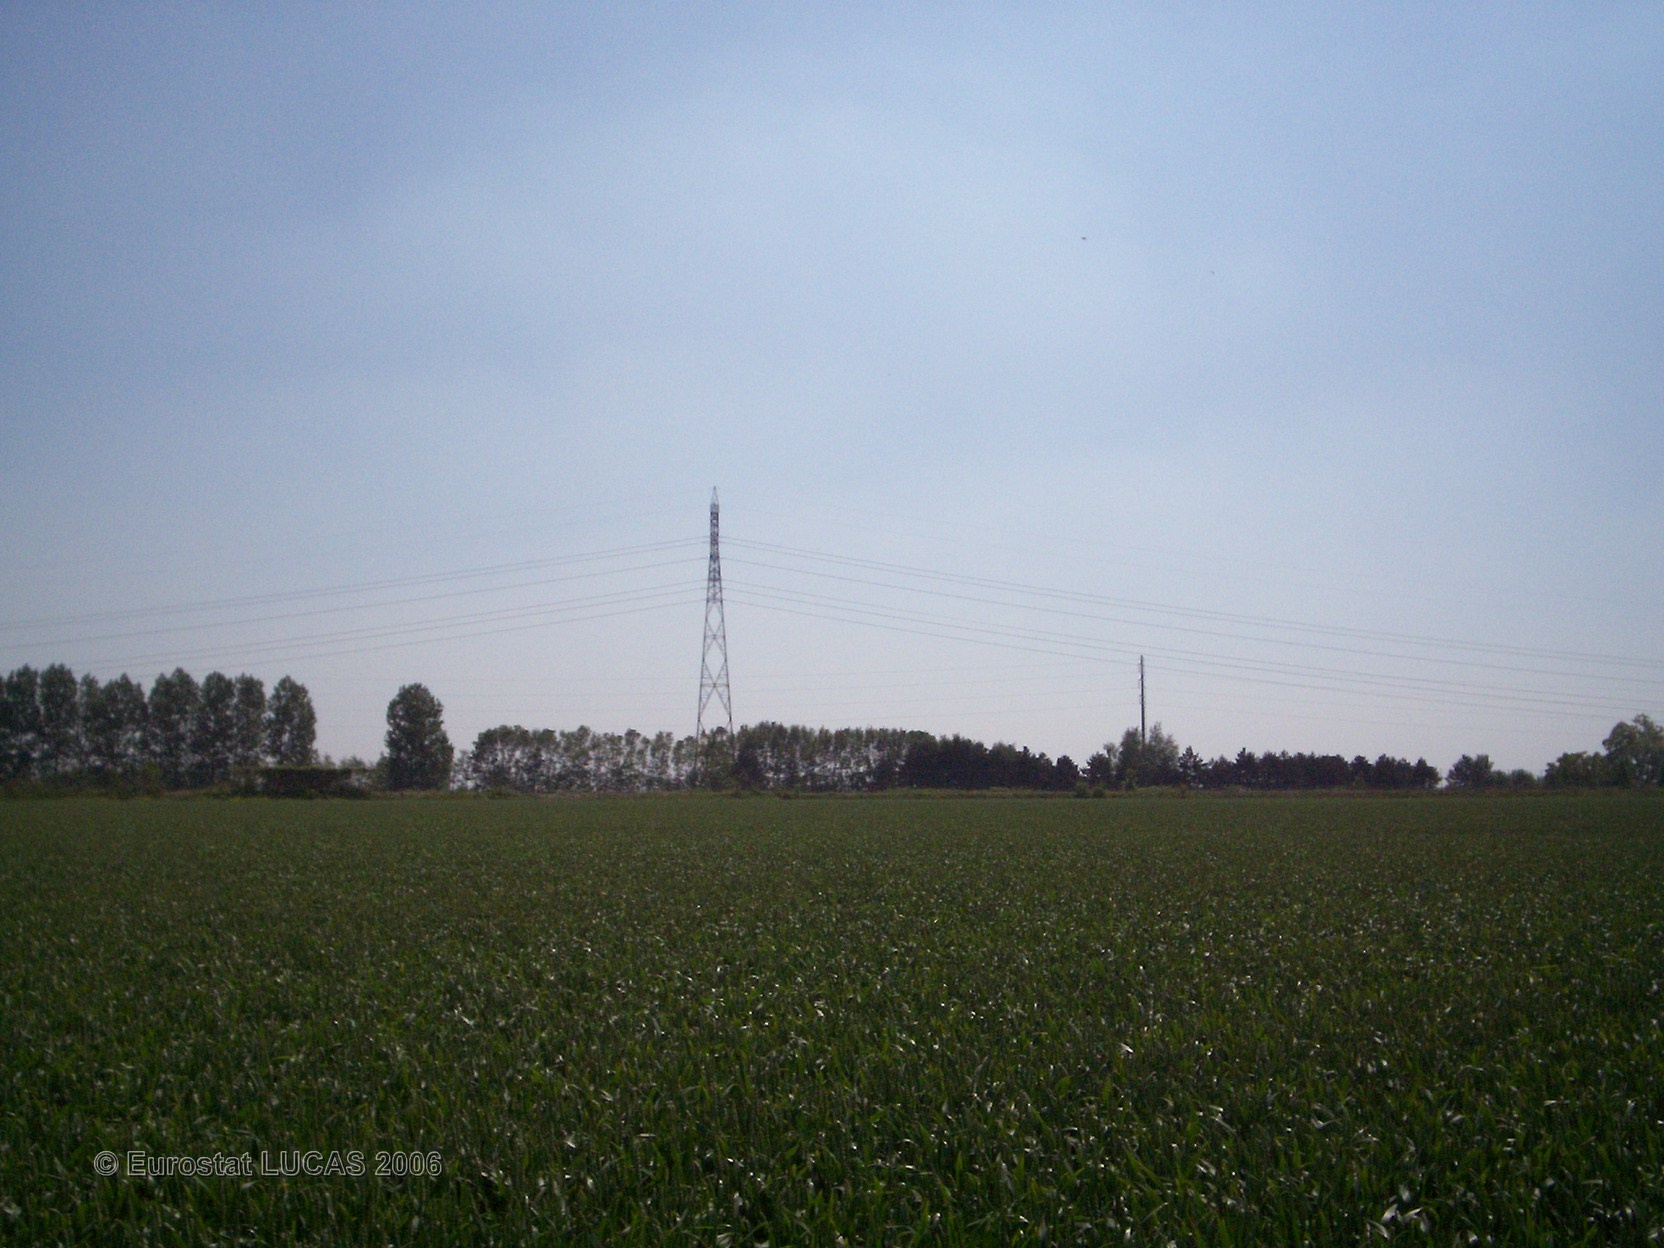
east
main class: Cropland
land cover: Common wheat
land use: Agriculture (excluding fallow land and kitchen gardens)
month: June
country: FR
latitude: 49.4995
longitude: 2.7124
